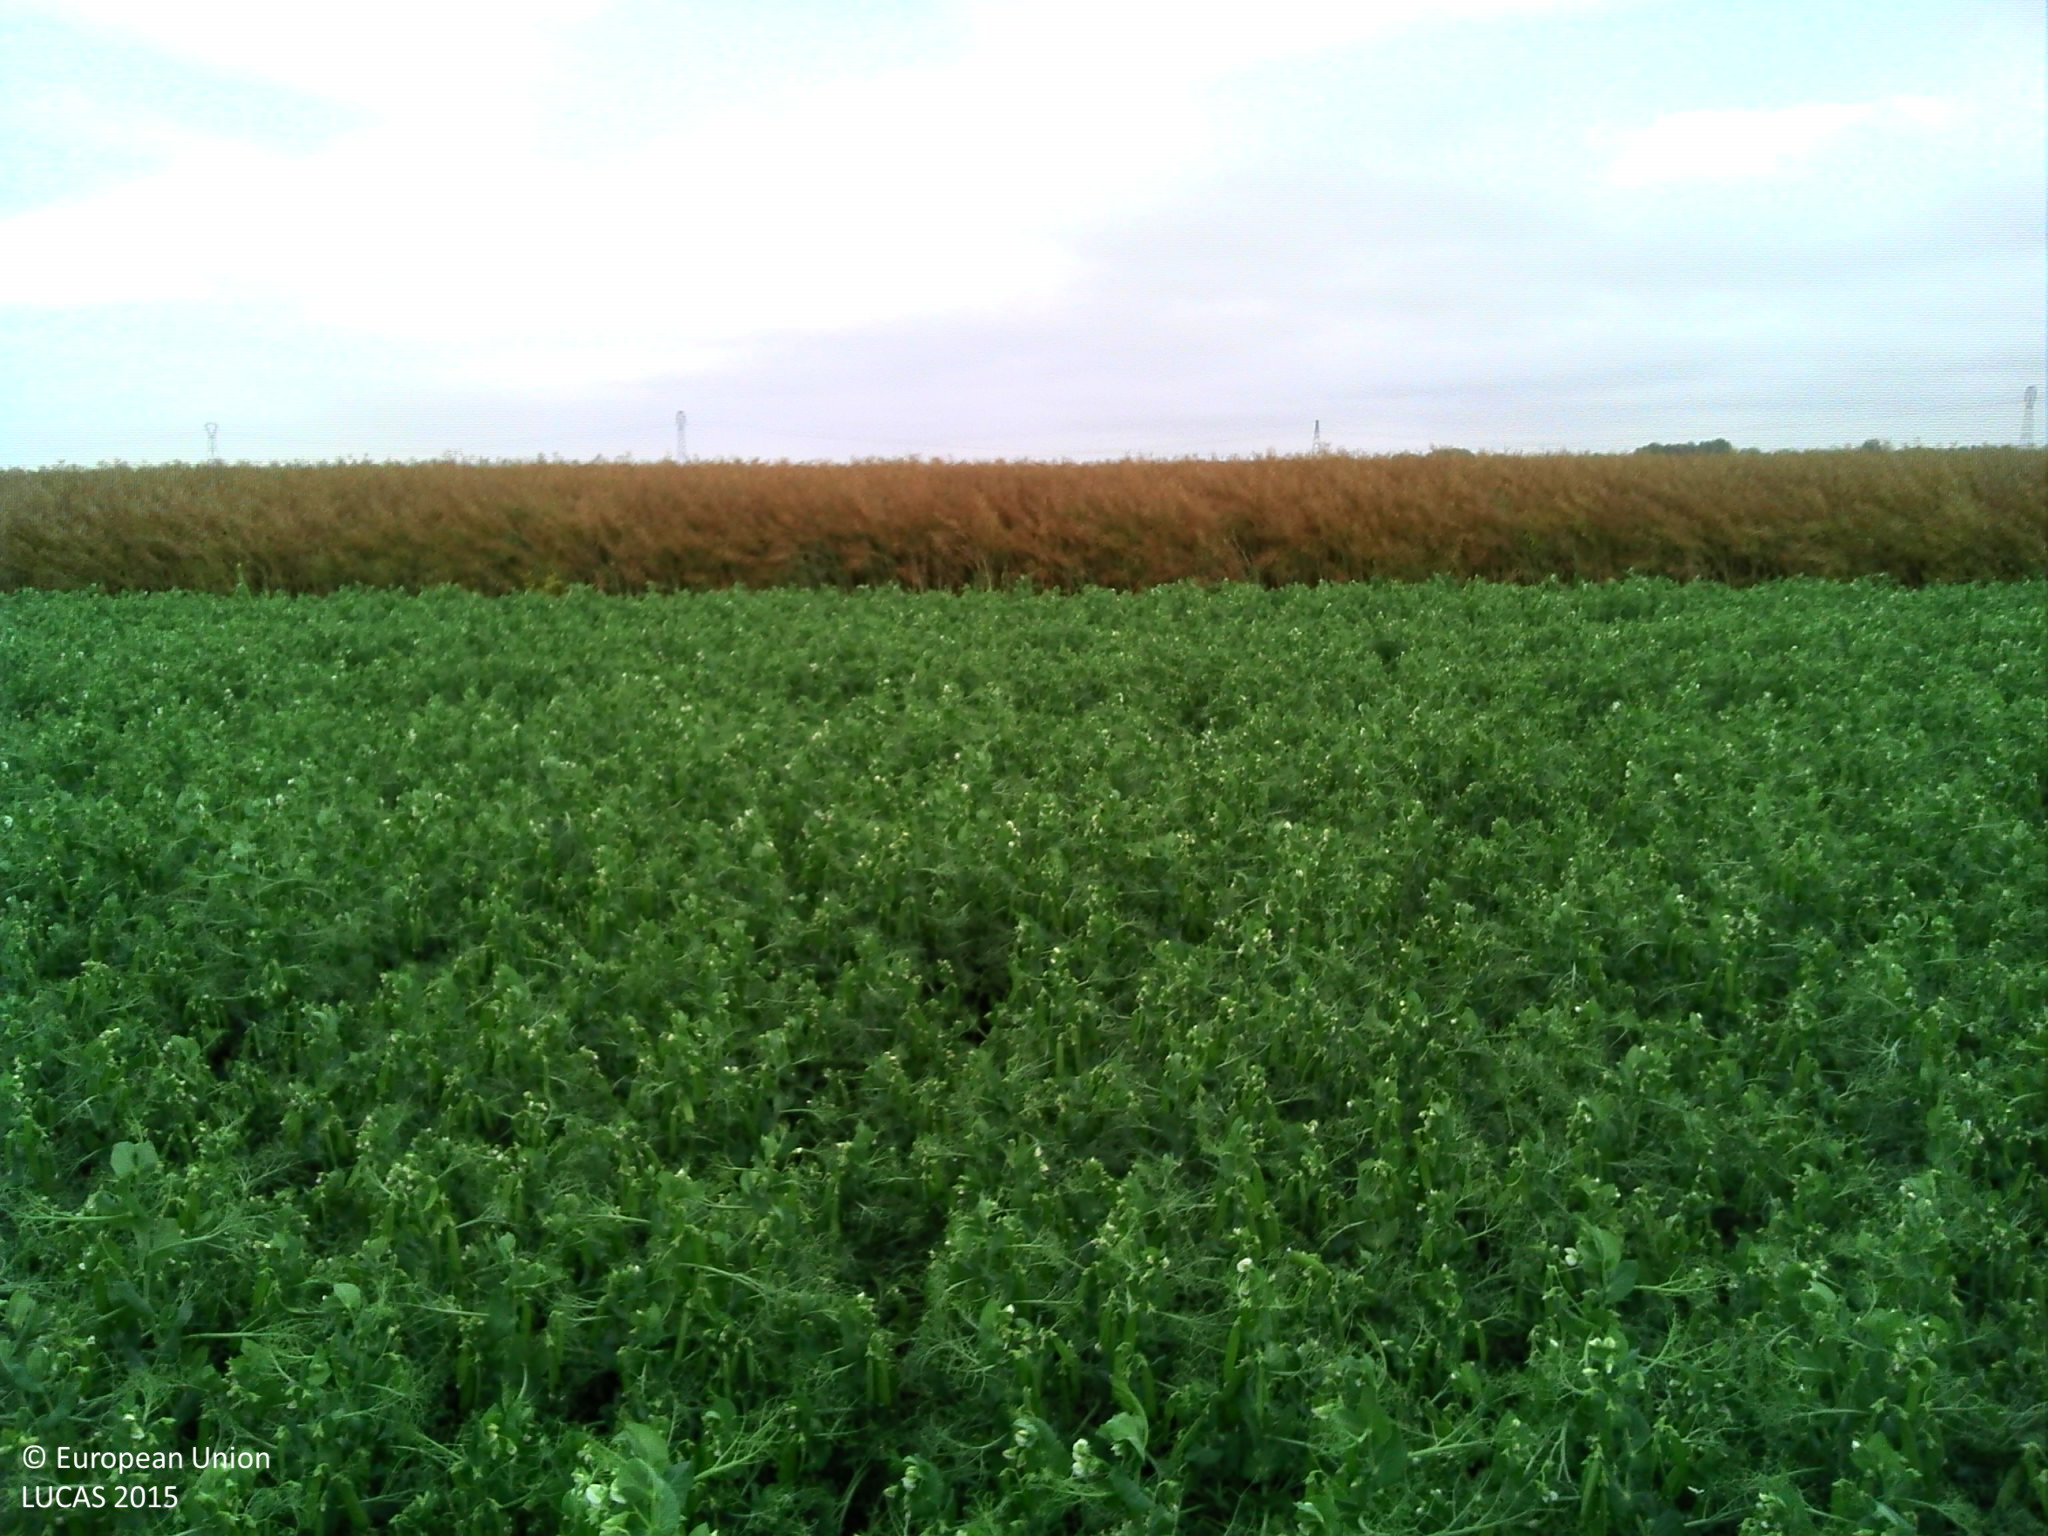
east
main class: Cropland
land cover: Dry pulses
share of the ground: > 75 %
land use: Agriculture (excluding fallow land and kitchen gardens)
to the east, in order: Dry pulses; Rape and turnip rape
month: July
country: FR
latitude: 50.9306
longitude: 2.2311
